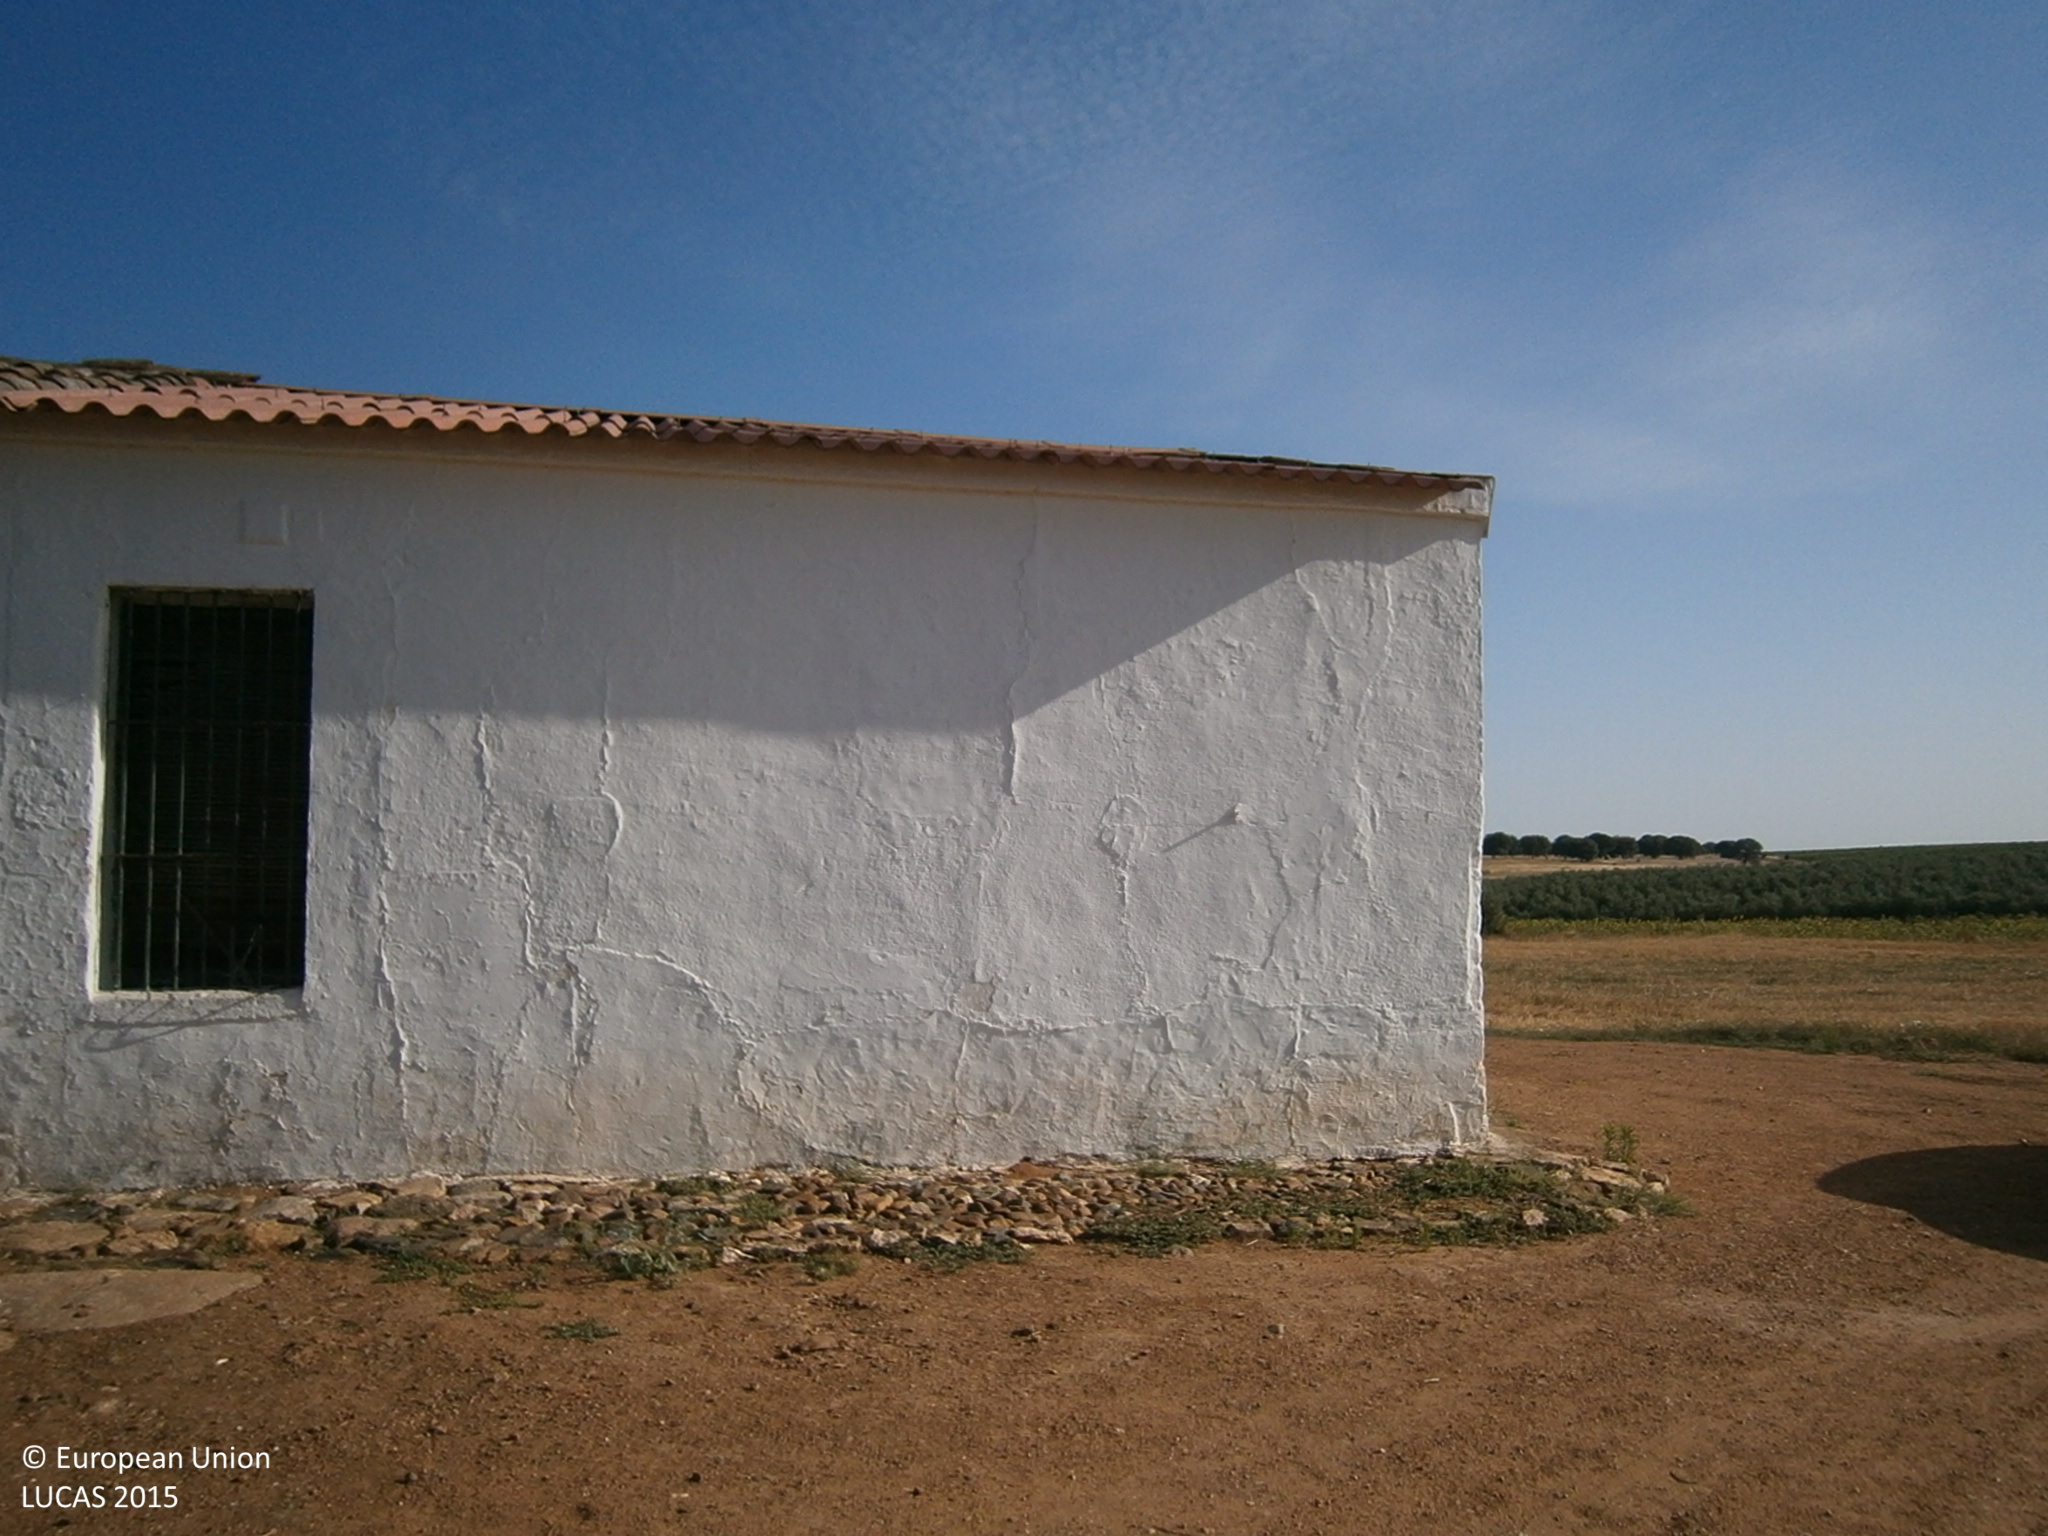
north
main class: Grassland
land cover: Grassland with sparse tree/shrub cover
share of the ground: > 75 %
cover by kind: herbaceous plants 90 %, broadleaved forest trees 5 %, unconsolidated bare surface 5 %
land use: Agriculture (excluding fallow land and kitchen gardens)
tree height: > 5 m
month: July
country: ES
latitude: 38.9900
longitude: -6.7026
